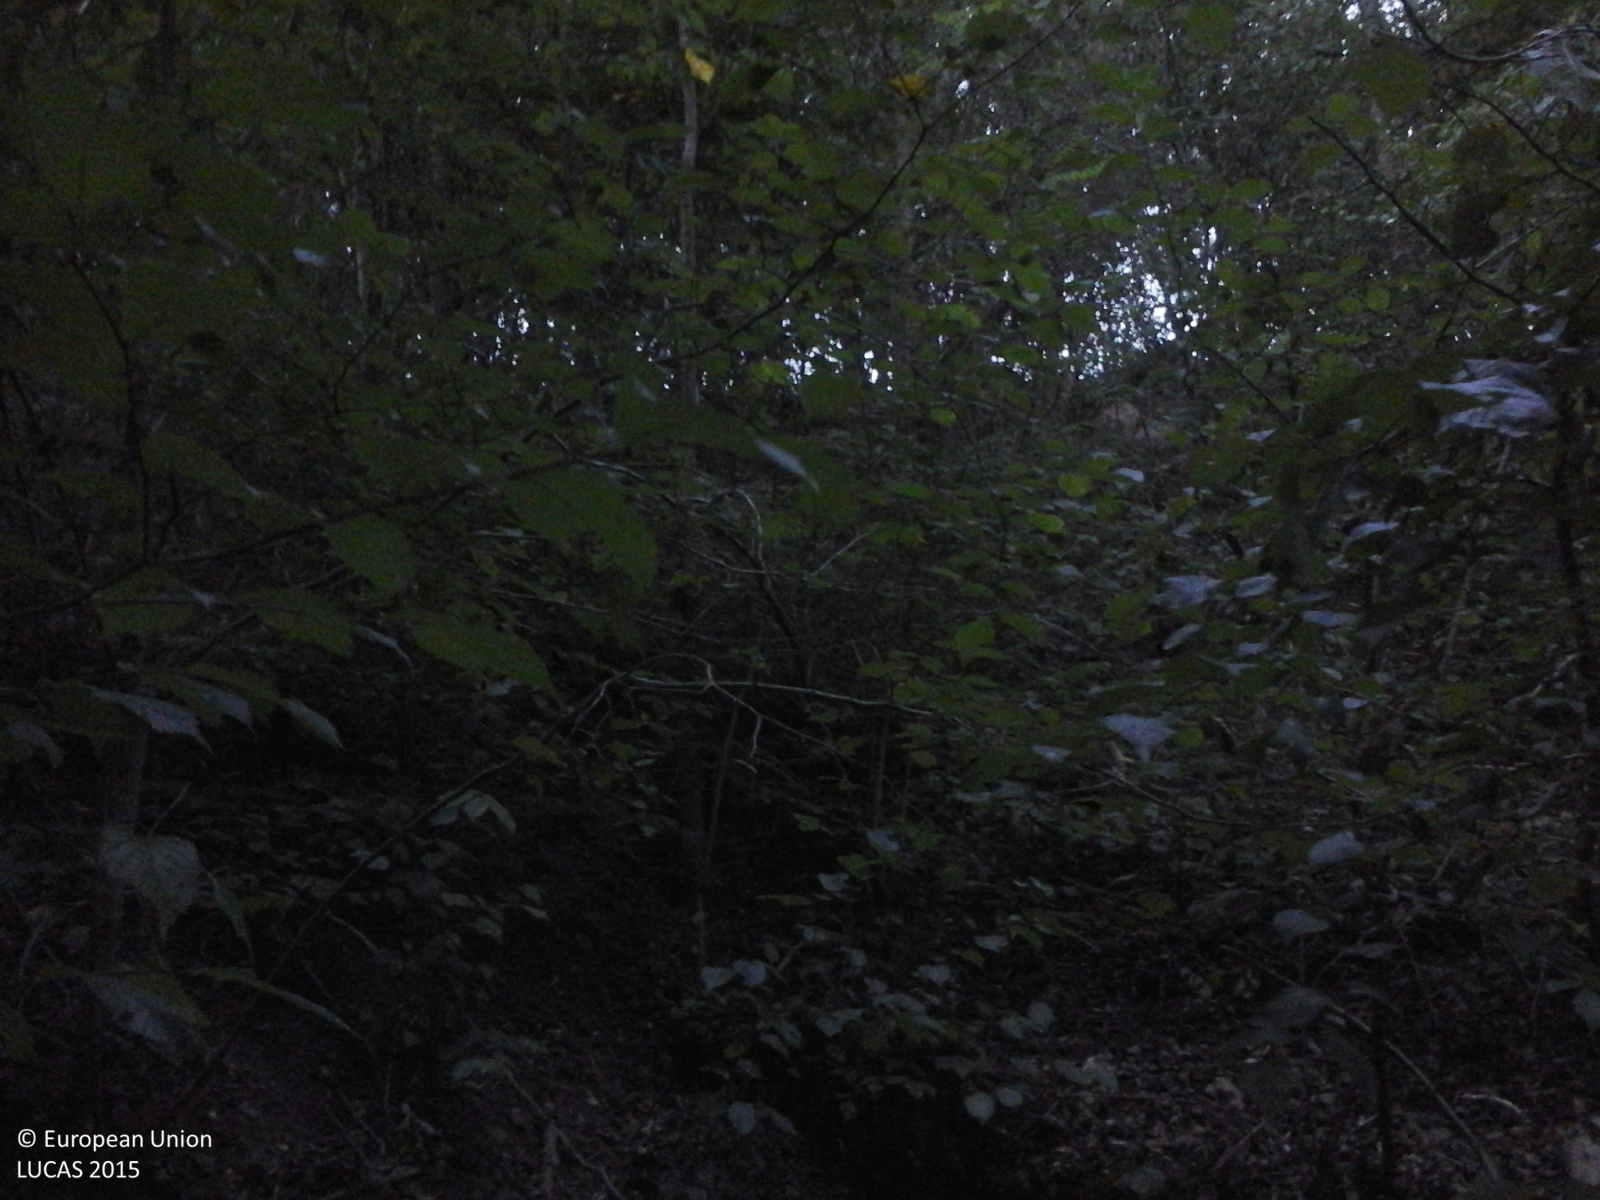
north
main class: Woodland
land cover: Broadleaved woodland
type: beech forest
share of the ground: > 75 %
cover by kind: broadleaved forest trees 100 %
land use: Forestry
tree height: > 5 m
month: September
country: RO
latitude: 47.2127
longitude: 23.4463
